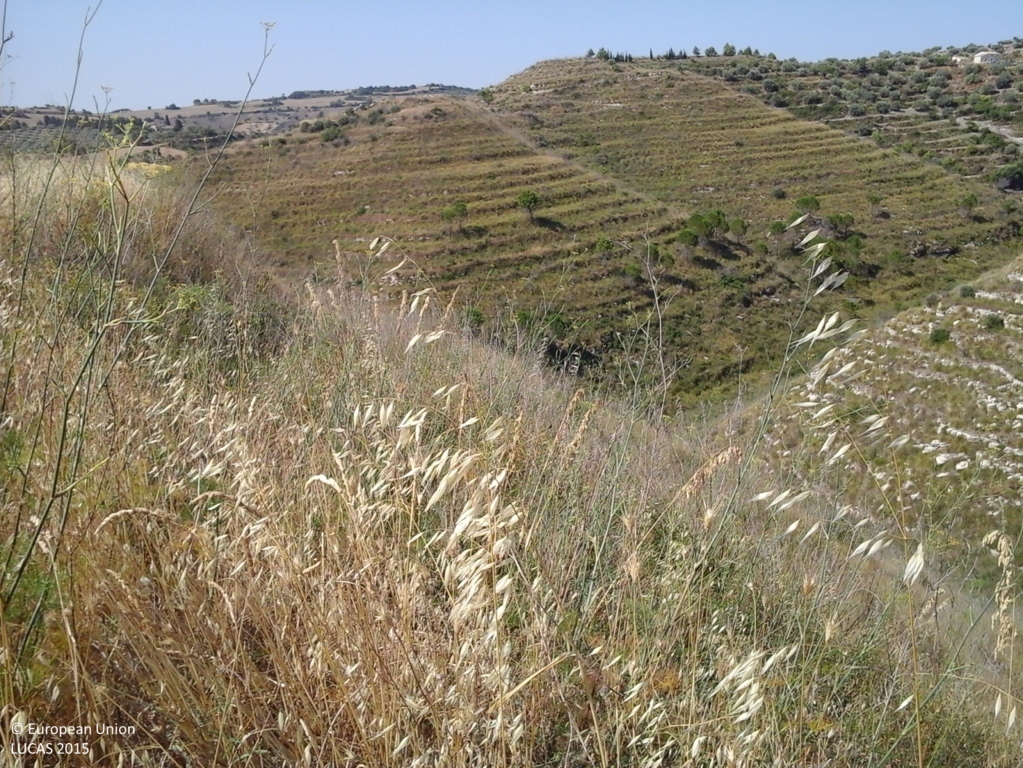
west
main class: Shrubland
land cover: Shrubland without tree cover
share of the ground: > 75 %
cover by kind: herbaceous plants 60 %, shrubs 40 %
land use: Fallow land
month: July
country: IT
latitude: 37.0053
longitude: 14.8506
